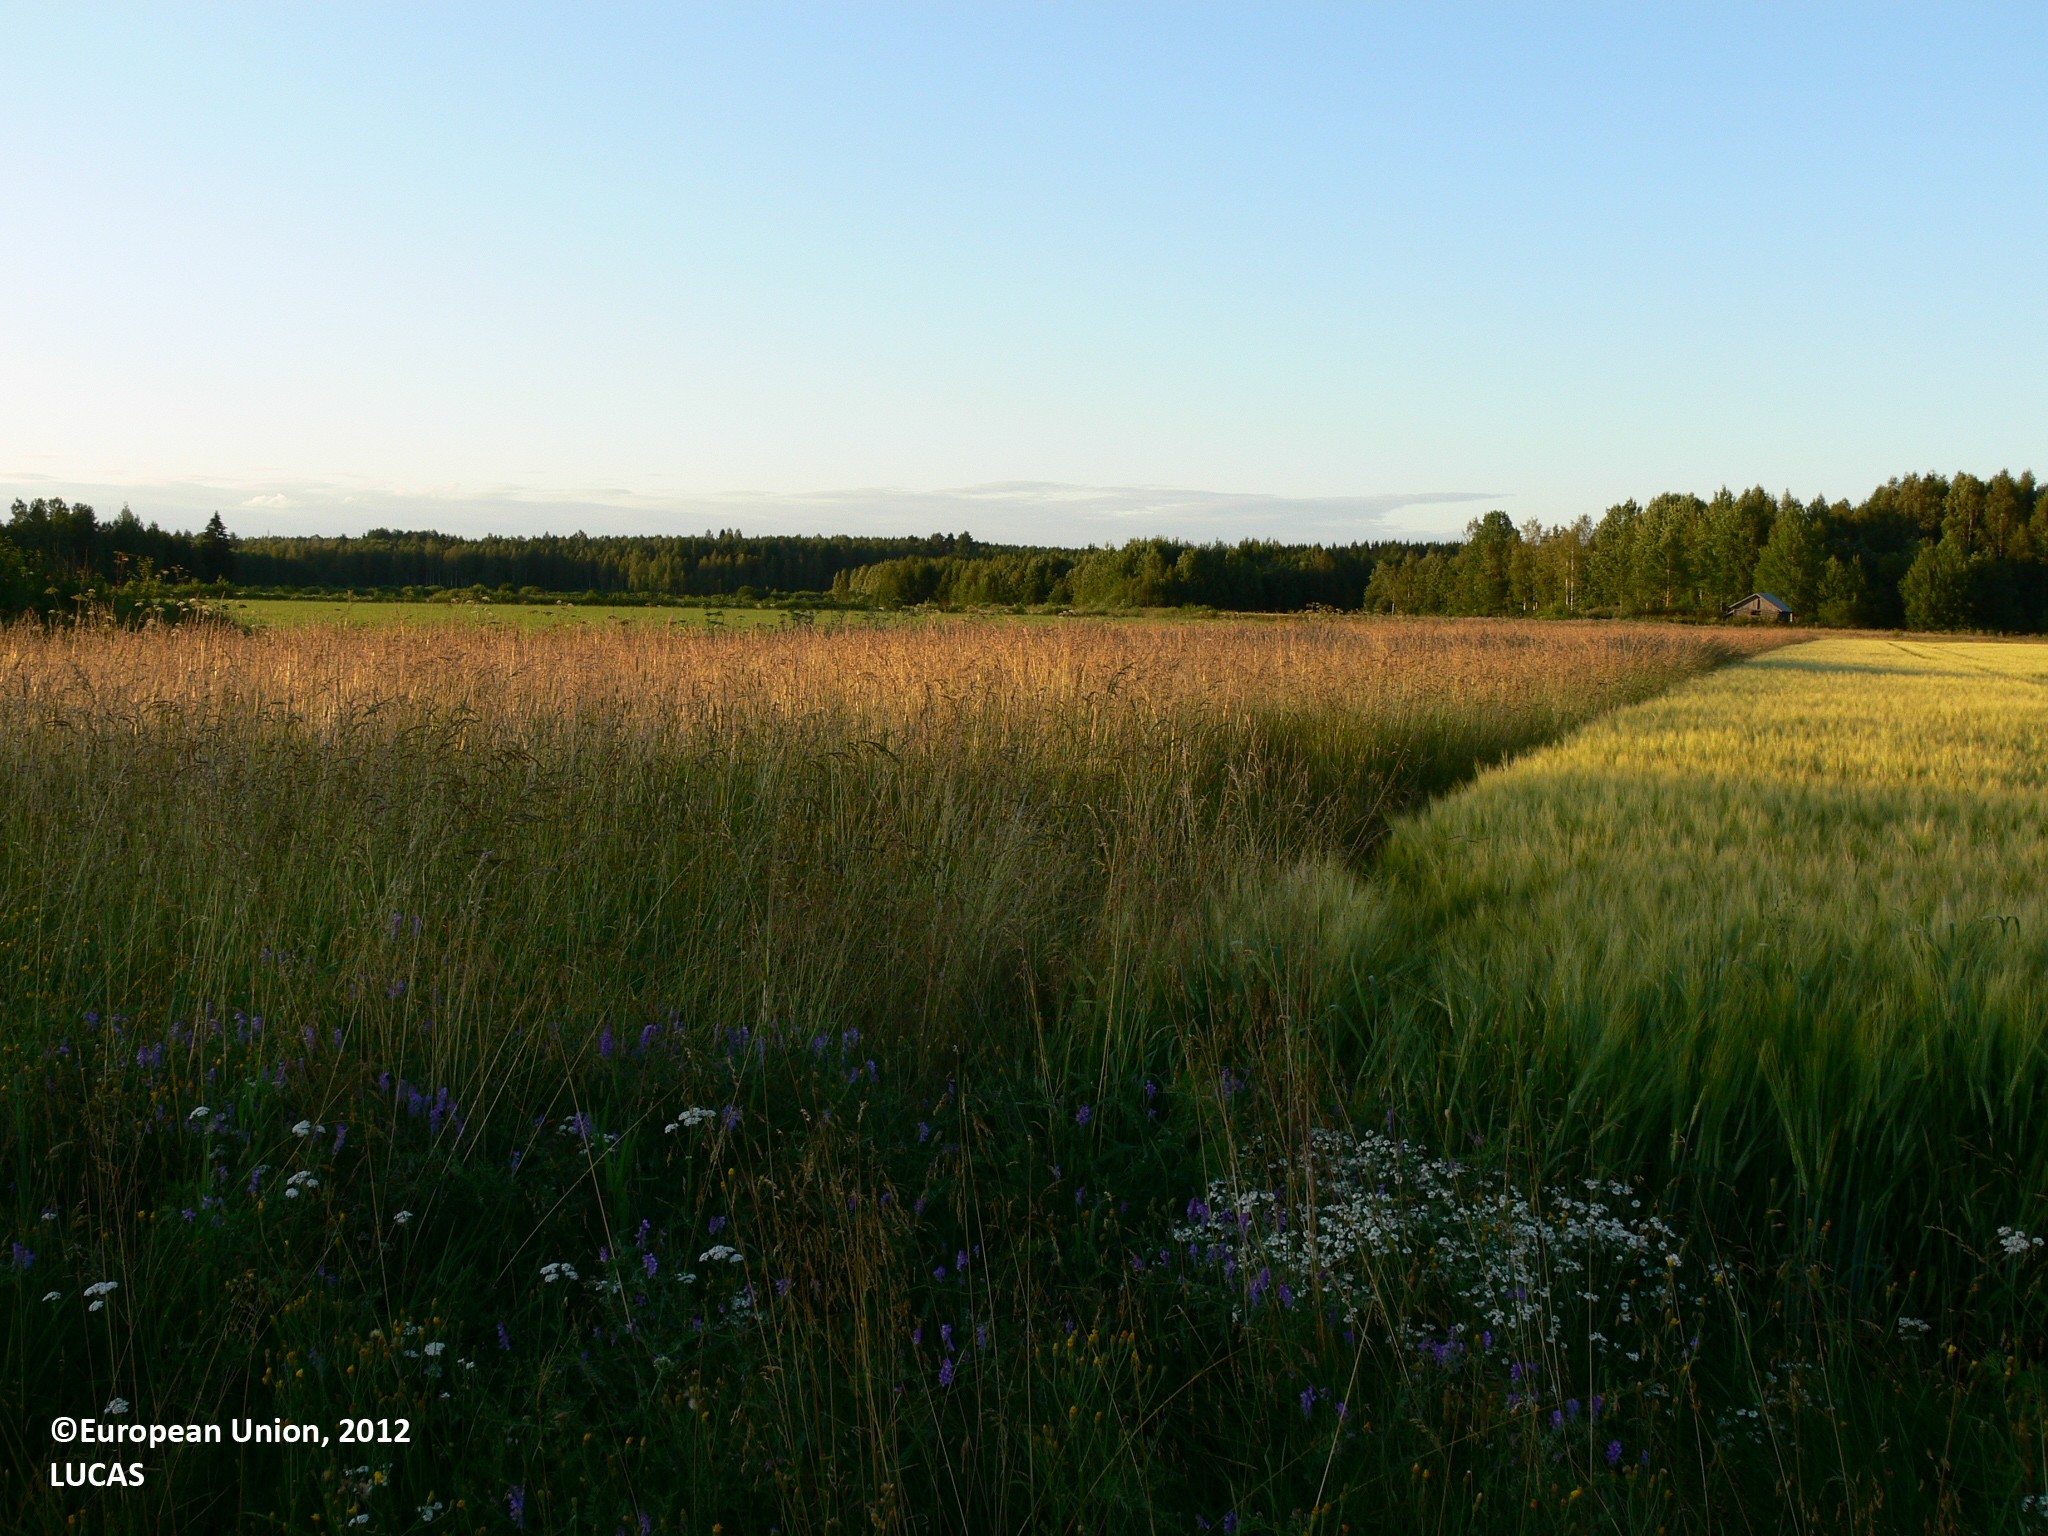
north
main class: Cropland
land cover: Barley
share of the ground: > 75 %
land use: Agriculture (excluding fallow land and kitchen gardens)
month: August
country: FI
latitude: 61.9091
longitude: 29.2544
